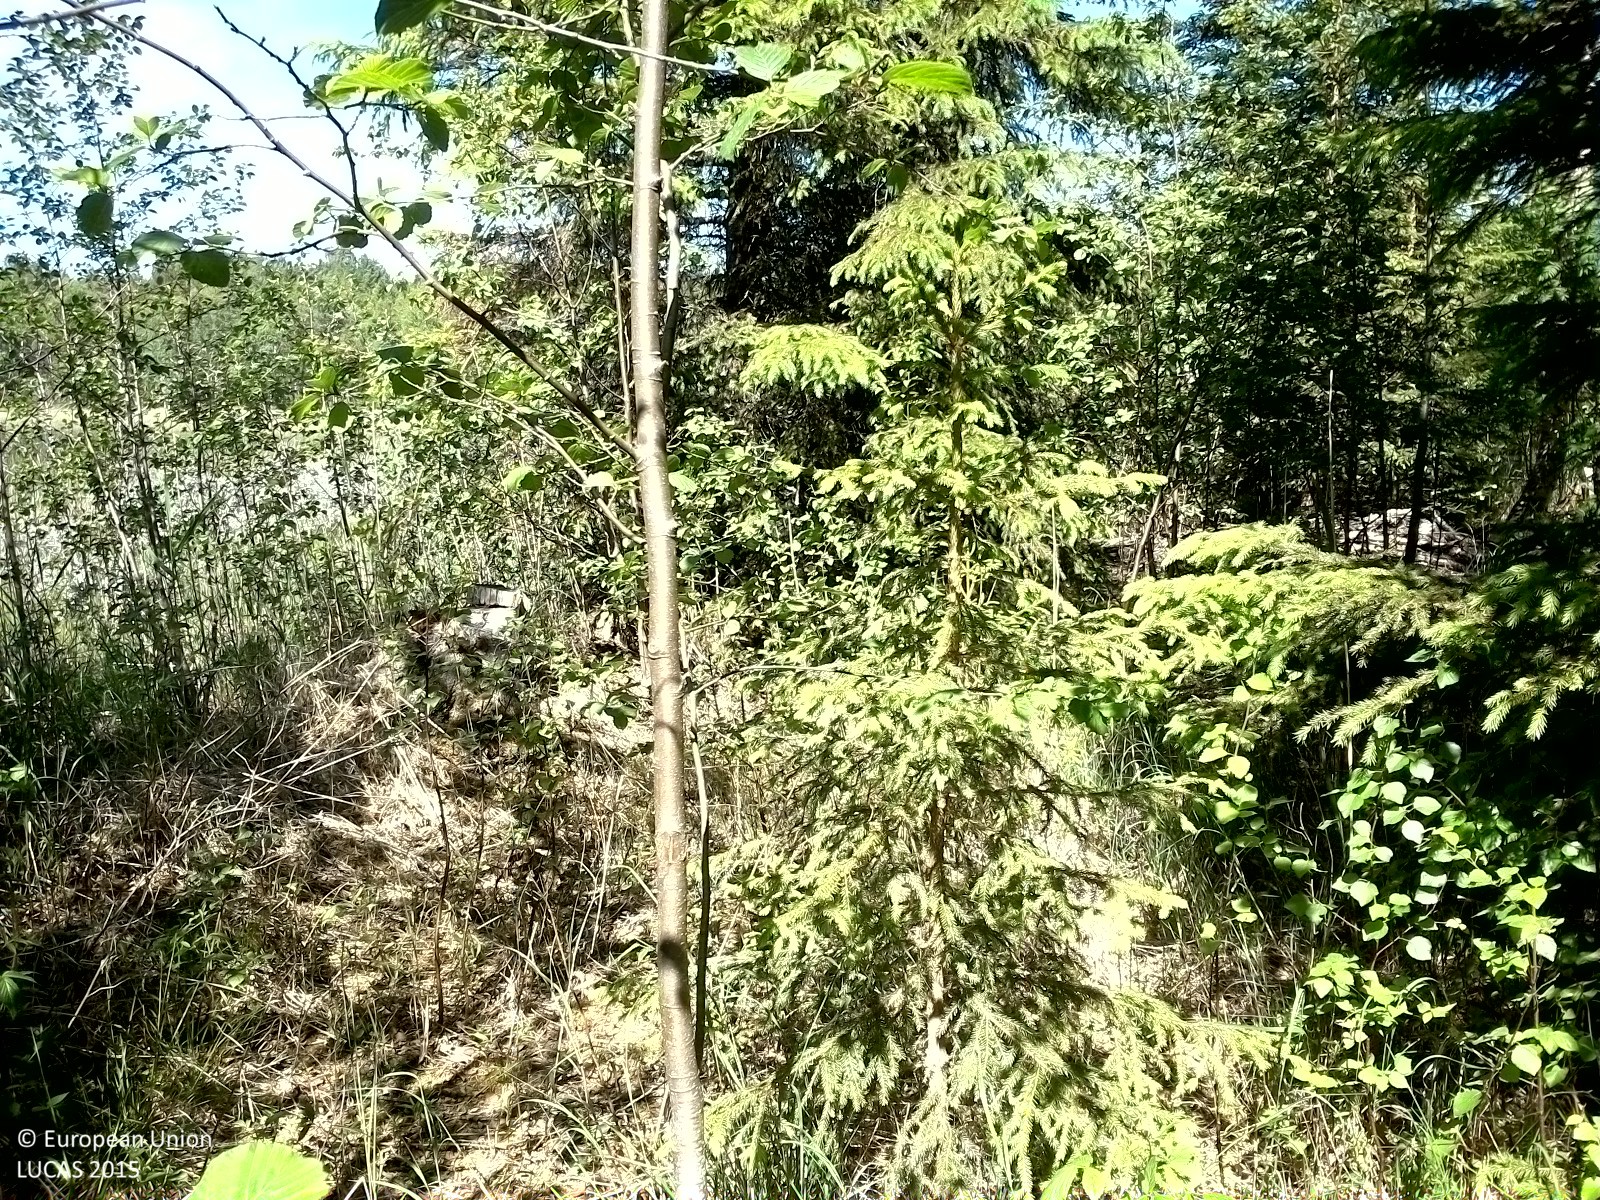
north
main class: Woodland
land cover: Spruce dominated mixed woodland
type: boreal forest
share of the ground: 50 - 75 %
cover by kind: broadleaved forest trees 40 %, herbaceous plants 40 %, coniferous forest trees 20 %
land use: Forestry
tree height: > 5 m
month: July
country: SE
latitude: 62.1334
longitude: 16.7893
